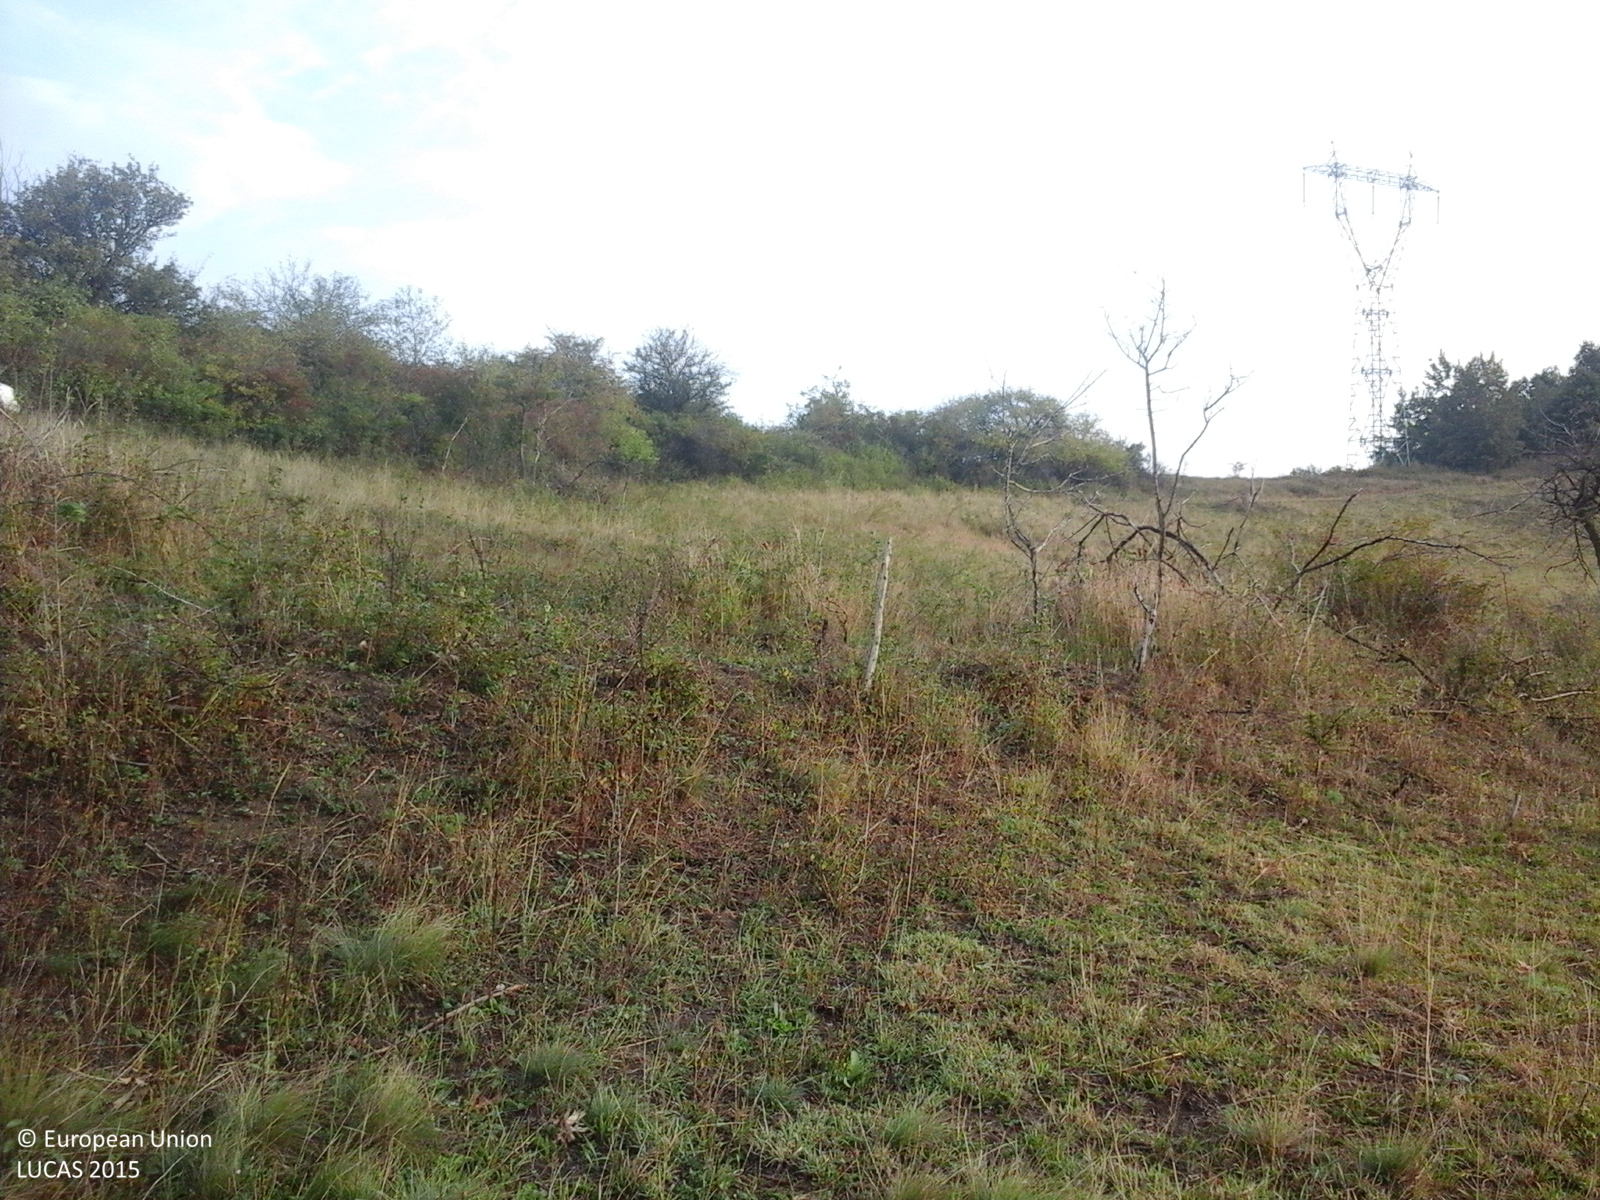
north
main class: Grassland
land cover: Grassland without tree/shrub cover
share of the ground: > 75 %
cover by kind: herbaceous plants 100 %
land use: Agriculture (excluding fallow land and kitchen gardens)
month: September
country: RO
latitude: 45.6576
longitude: 22.8987
